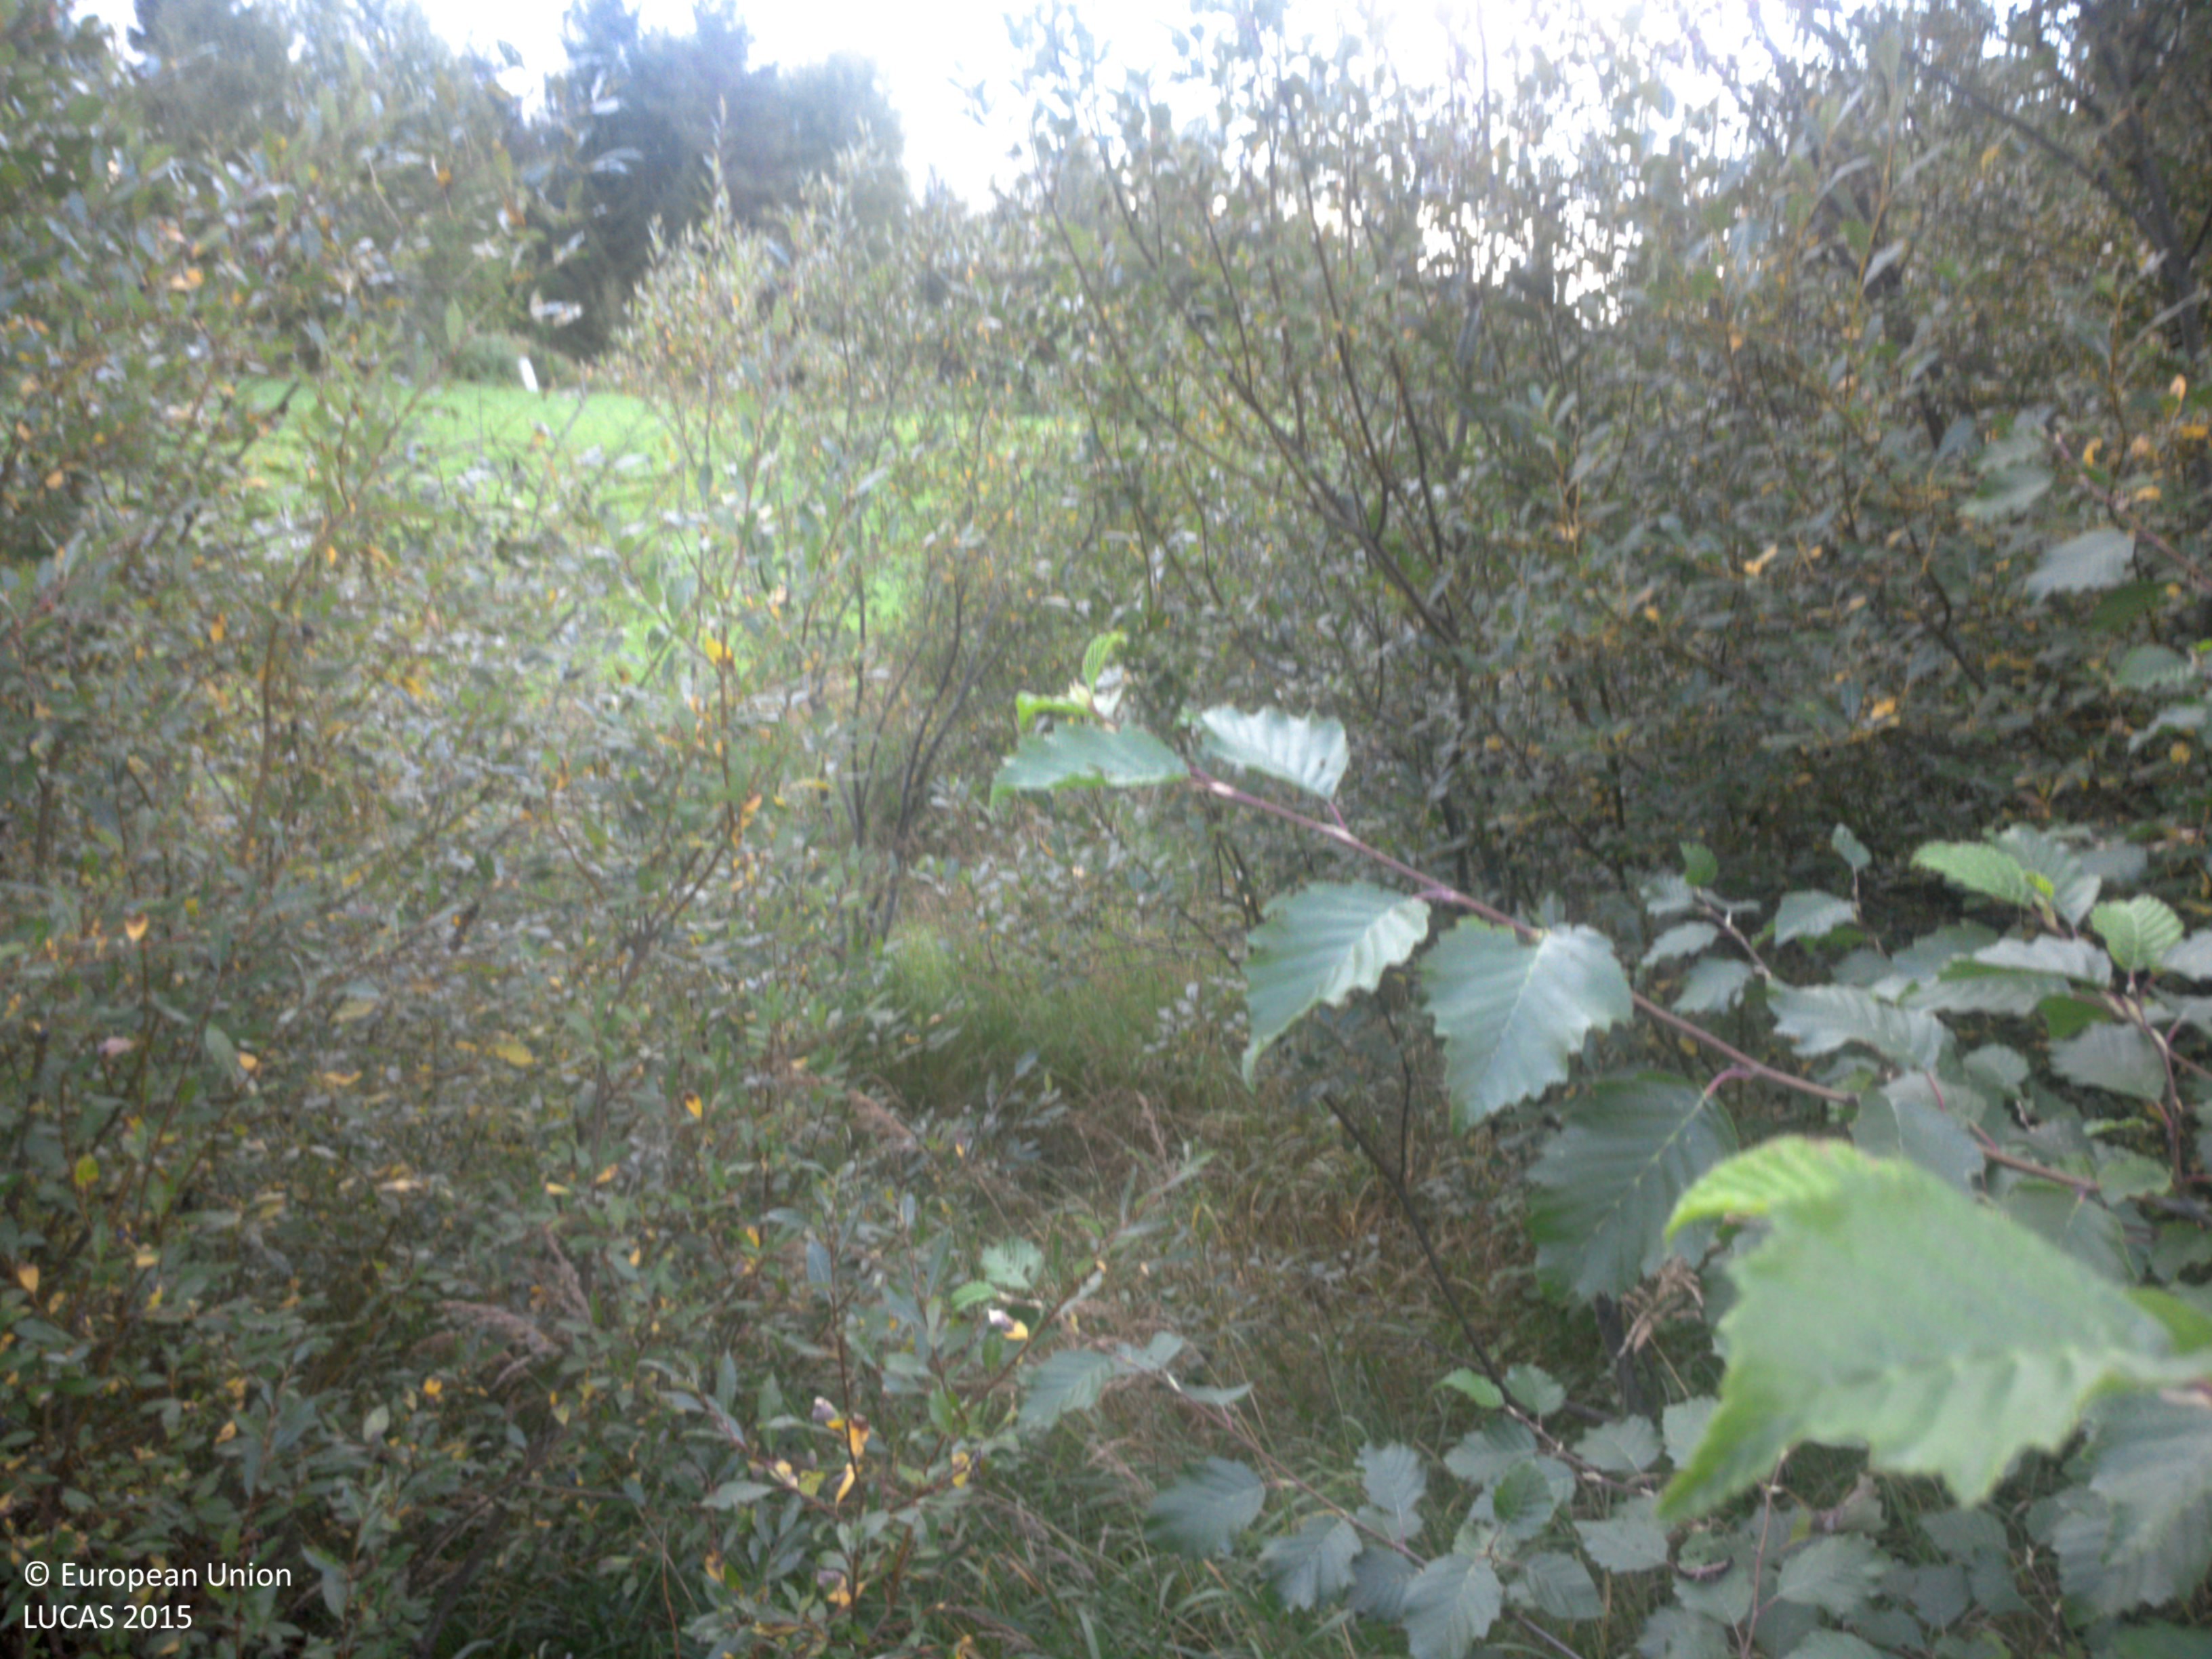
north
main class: Woodland
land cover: Broadleaved woodland
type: hemiboreal forest and nemoral coniferous forest and mixed broadleaved-coniferous forest
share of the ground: 50 - 75 %
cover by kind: broadleaved forest trees 50 %, herbaceous plants 45 %, coniferous forest trees 5 %
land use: Semi-natural and natural areas not in use
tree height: < 5 m
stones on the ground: < 10 %
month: August
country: SE
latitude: 63.8625
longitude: 20.0104
